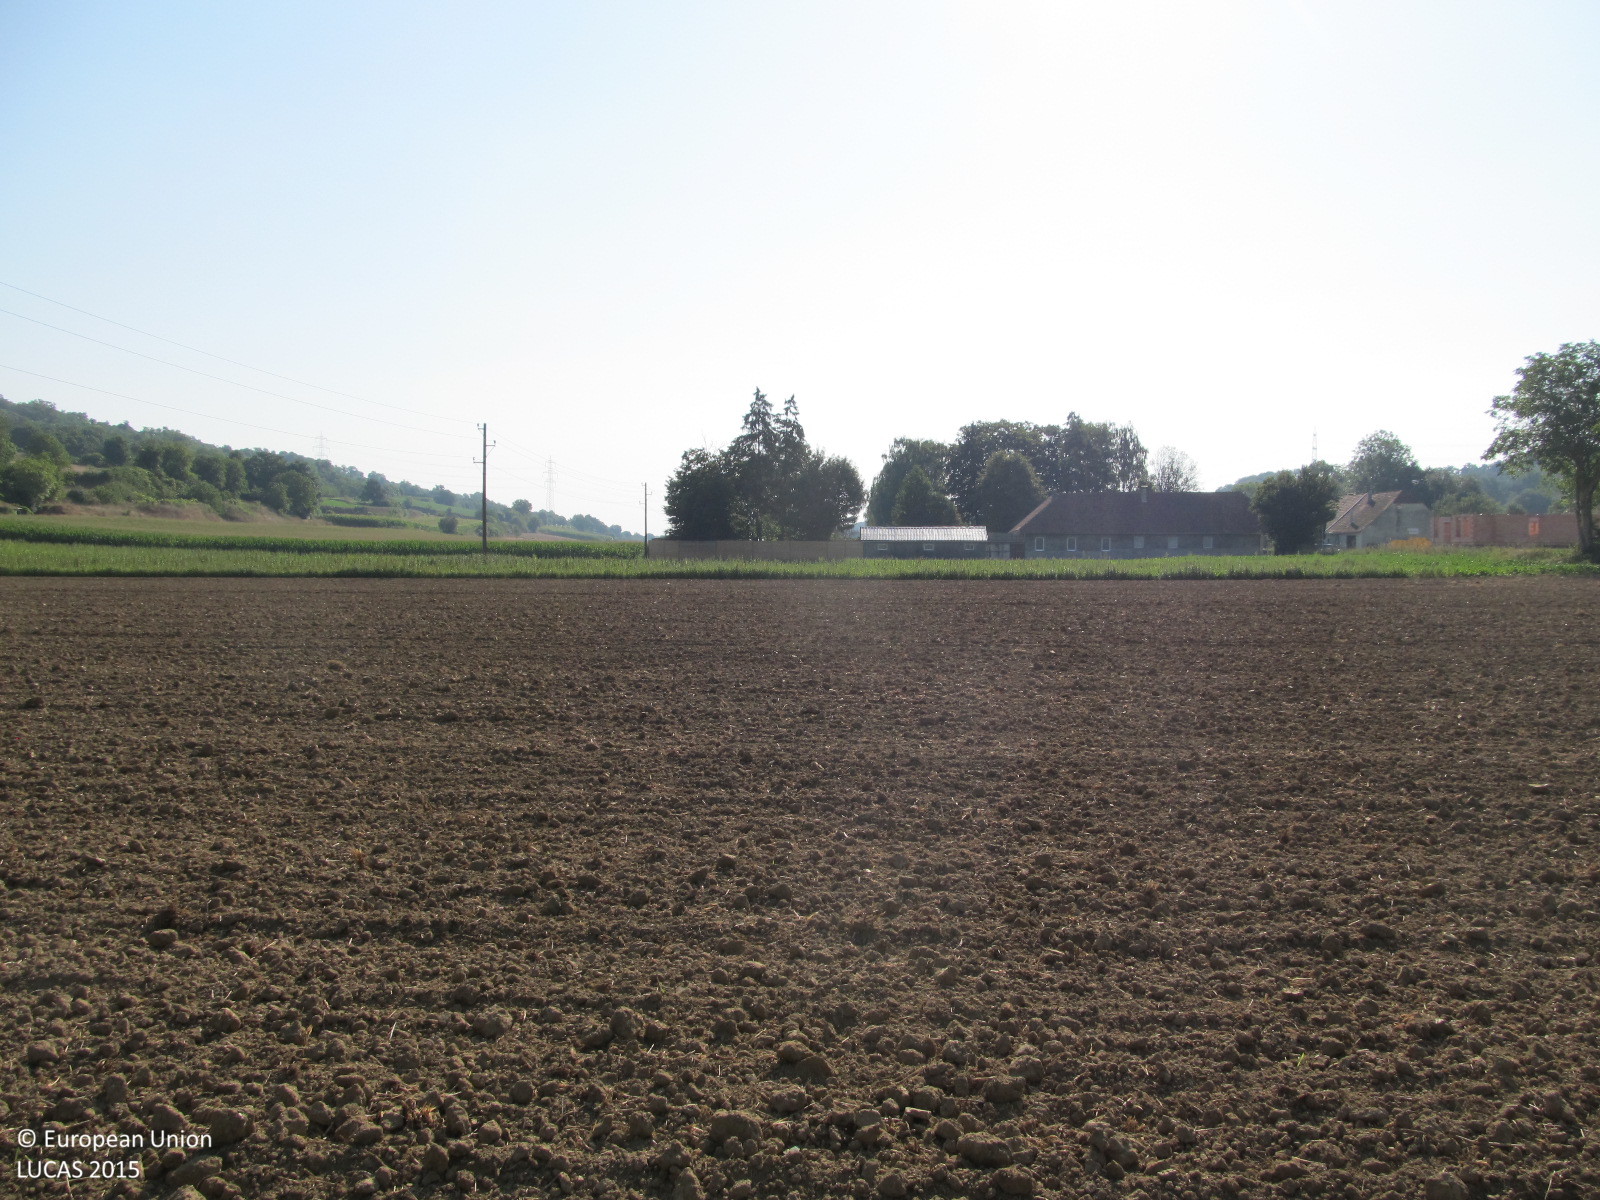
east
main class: Cropland
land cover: Maize
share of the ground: > 75 %
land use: Agriculture (excluding fallow land and kitchen gardens)
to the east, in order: Maize; Common wheat; Sugar beet; Artificial constructions in urban areas; Broadleaved woodland; Fences; Maize
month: August
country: AT
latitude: 48.3032
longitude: 15.8410
